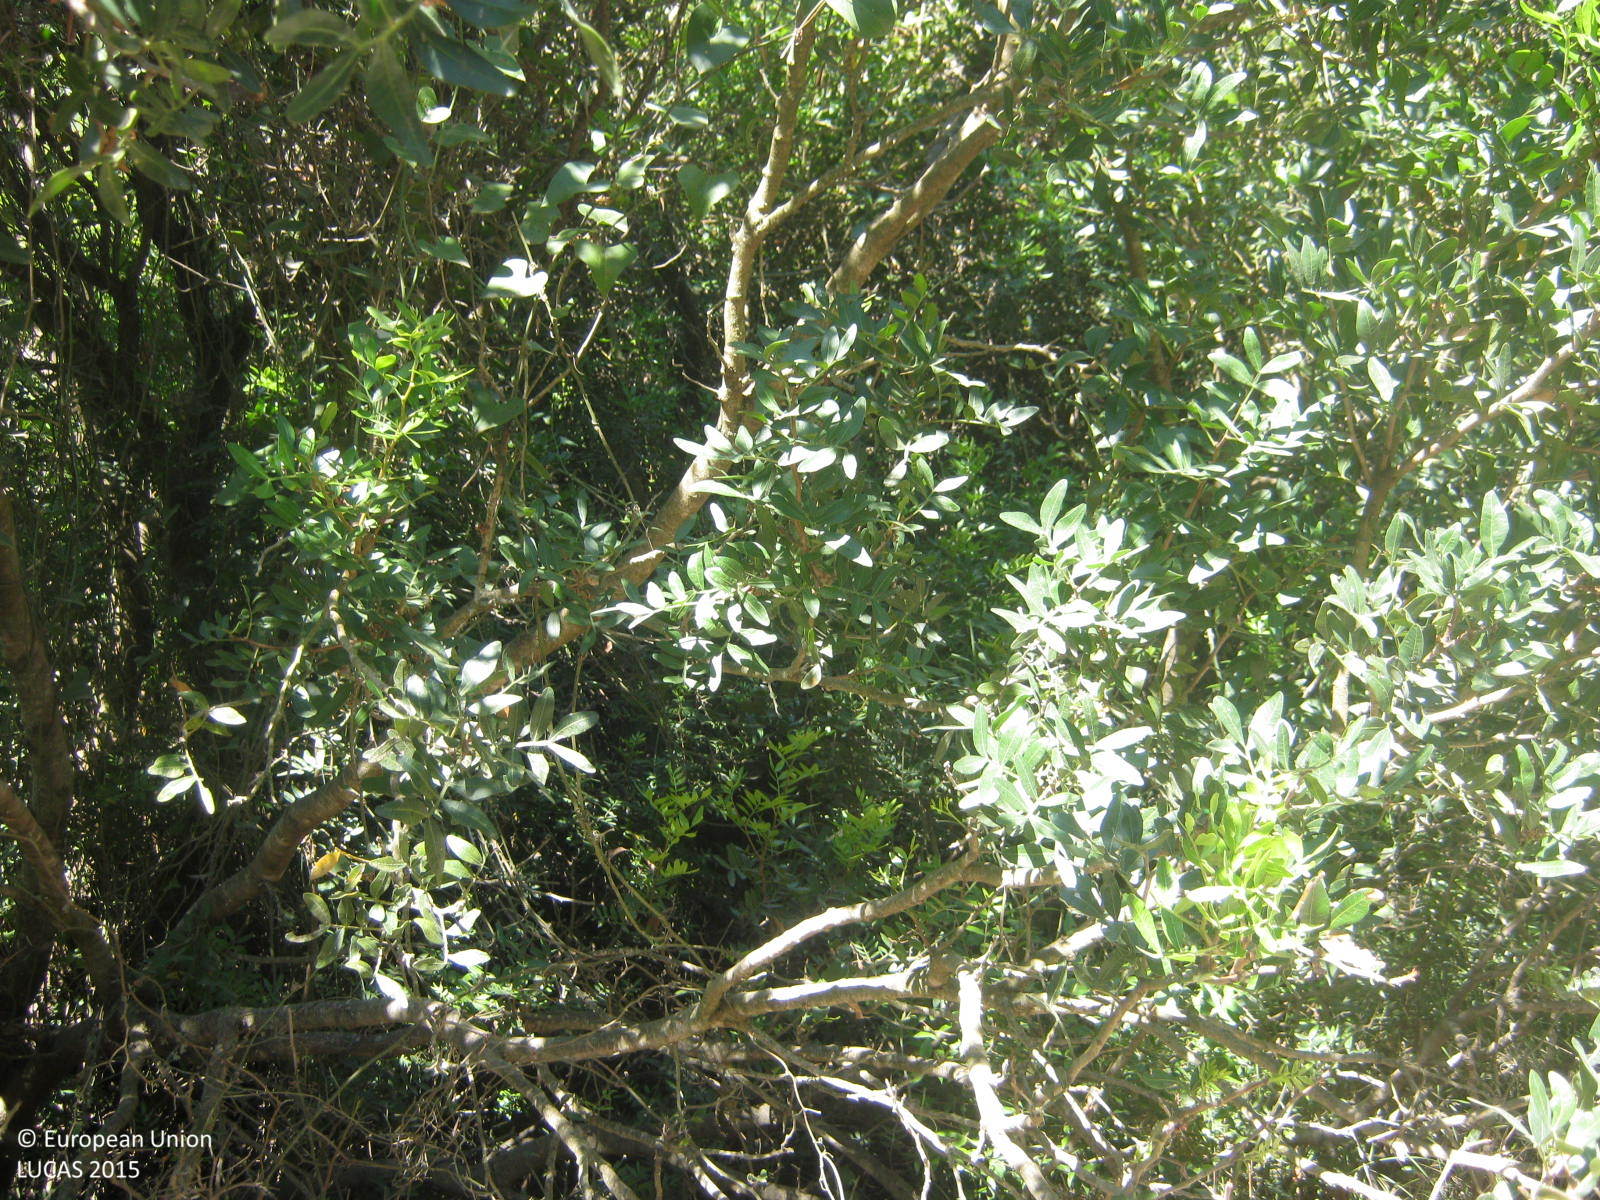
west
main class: Grassland
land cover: Grassland with sparse tree/shrub cover
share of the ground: > 75 %
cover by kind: herbaceous plants 75 %, shrubs 10 %, unconsolidated bare surface 10 %, broadleaved forest trees 5 %
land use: Fallow land
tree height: < 5 m
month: June
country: GR
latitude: 38.8289
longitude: 20.8086
